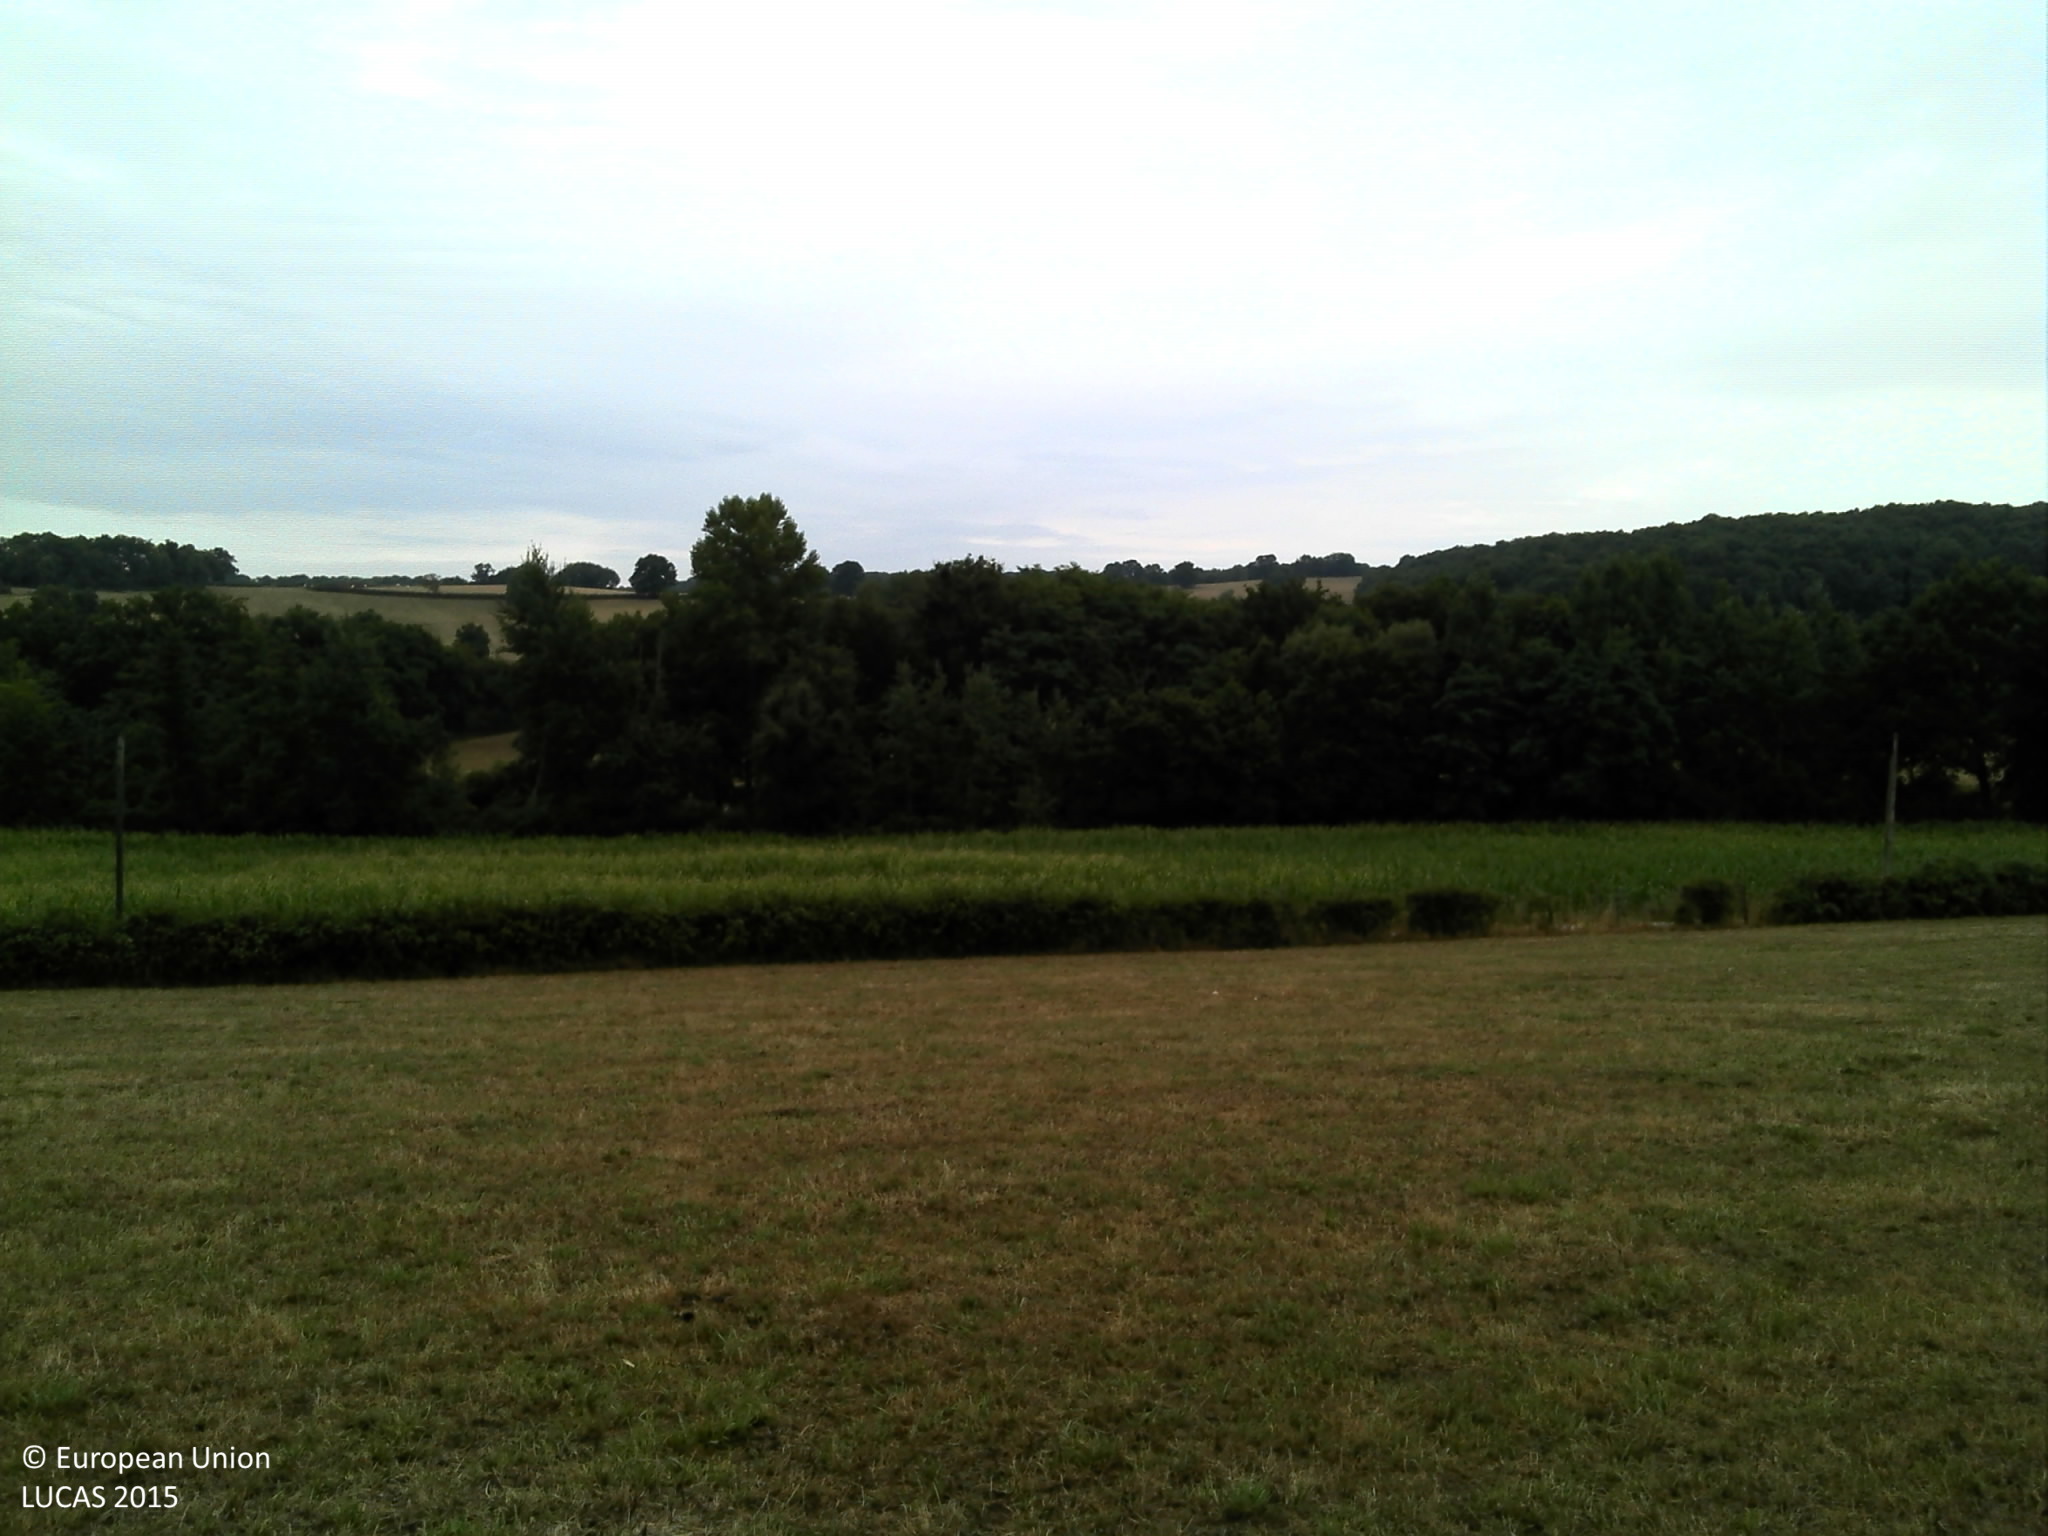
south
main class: Grassland
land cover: Grassland without tree/shrub cover
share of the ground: > 75 %
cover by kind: herbaceous plants 100 %
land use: Agriculture (excluding fallow land and kitchen gardens)
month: August
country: FR
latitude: 46.1485
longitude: 4.0326
